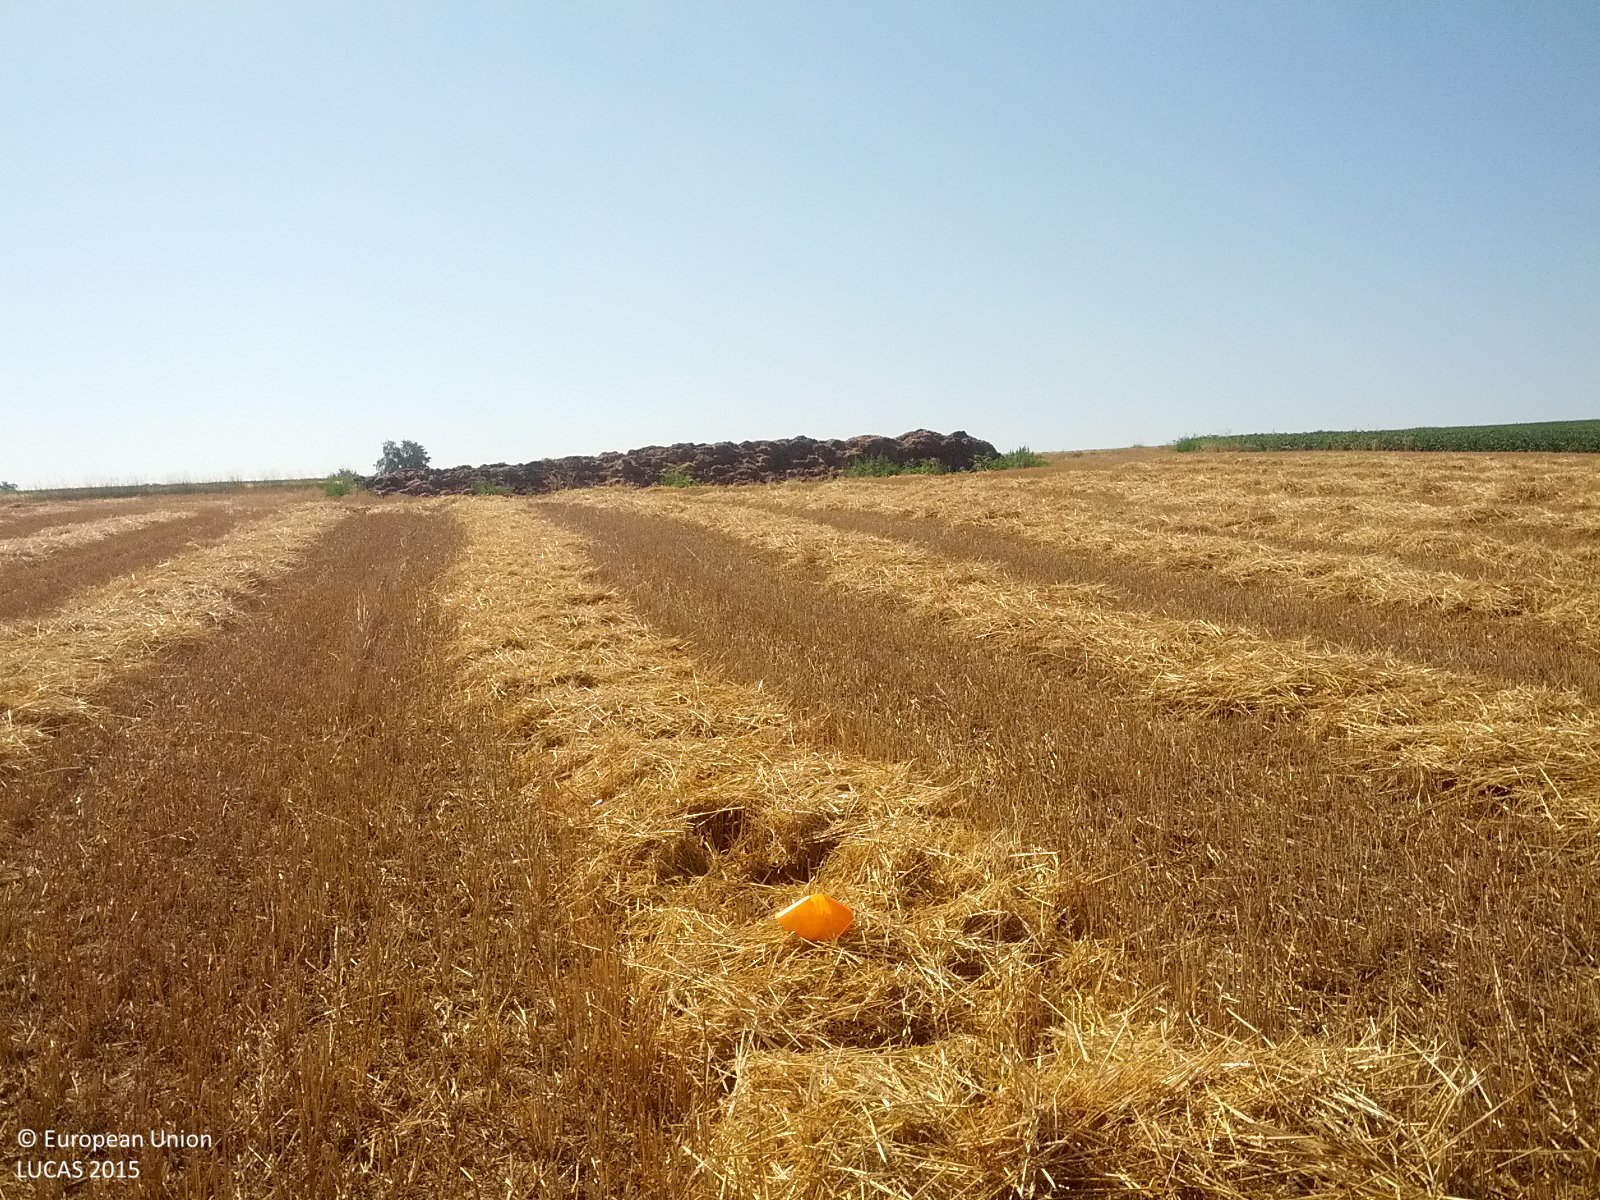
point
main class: Cropland
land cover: Common wheat
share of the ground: > 75 %
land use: Agriculture (excluding fallow land and kitchen gardens)
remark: Harvested field
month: July
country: AT
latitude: 48.4873
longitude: 16.1067
